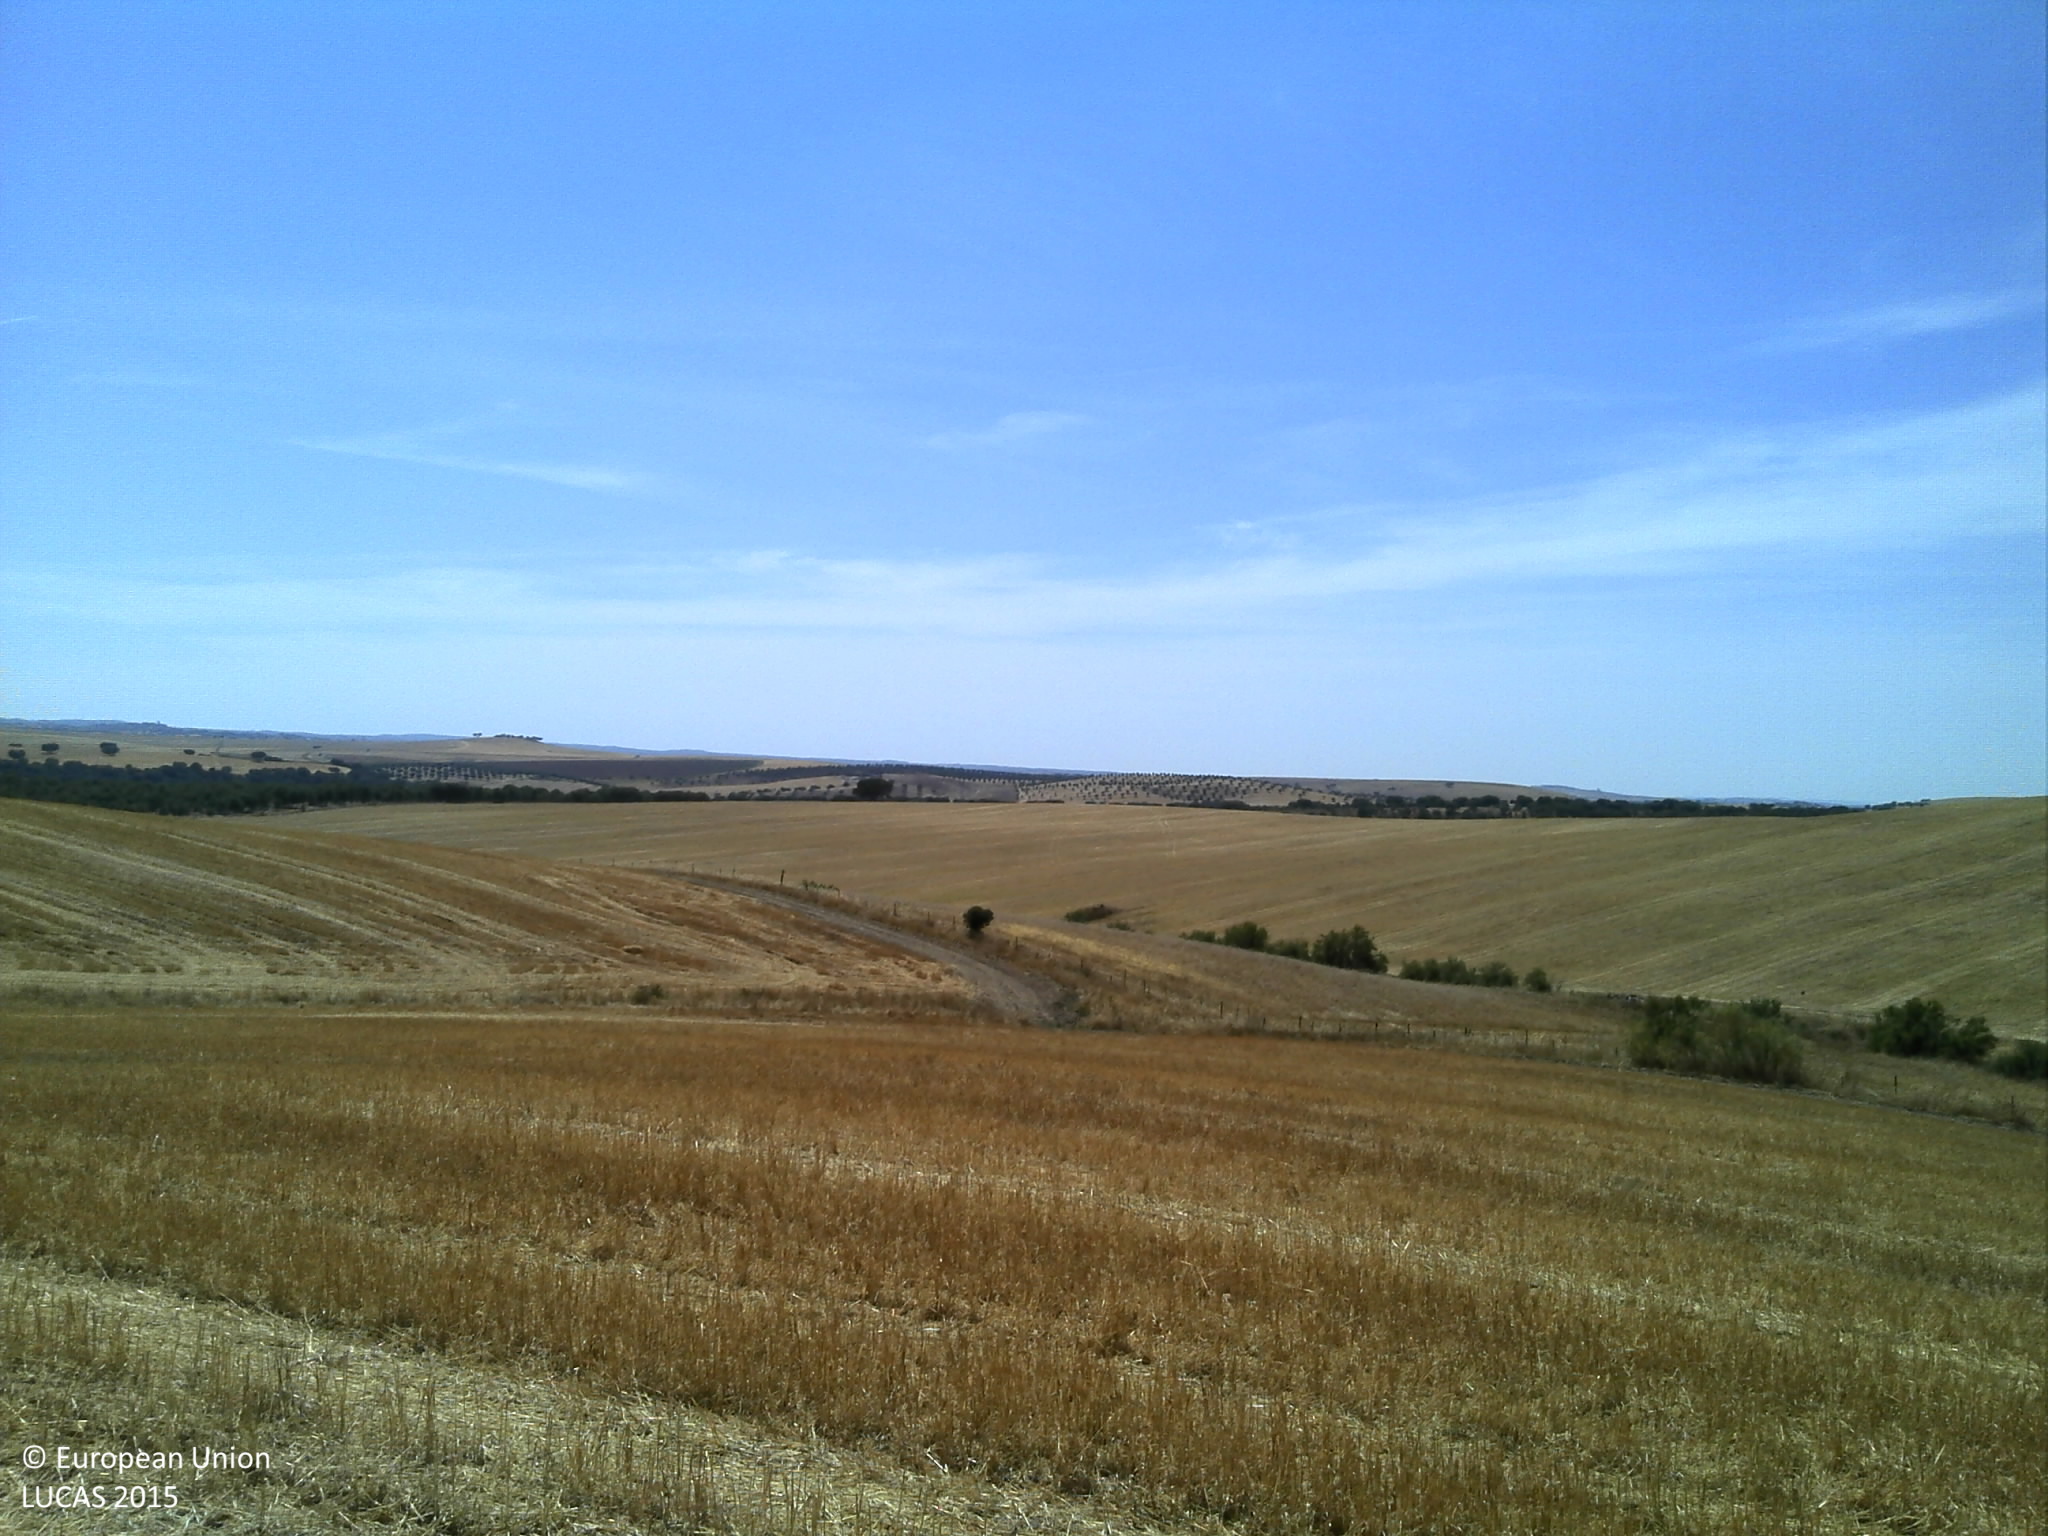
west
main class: Cropland
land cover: Oats
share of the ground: < 10 %
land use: Agriculture (excluding fallow land and kitchen gardens)
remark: Harvested field
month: July
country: PT
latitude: 38.4115
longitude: -7.6557
